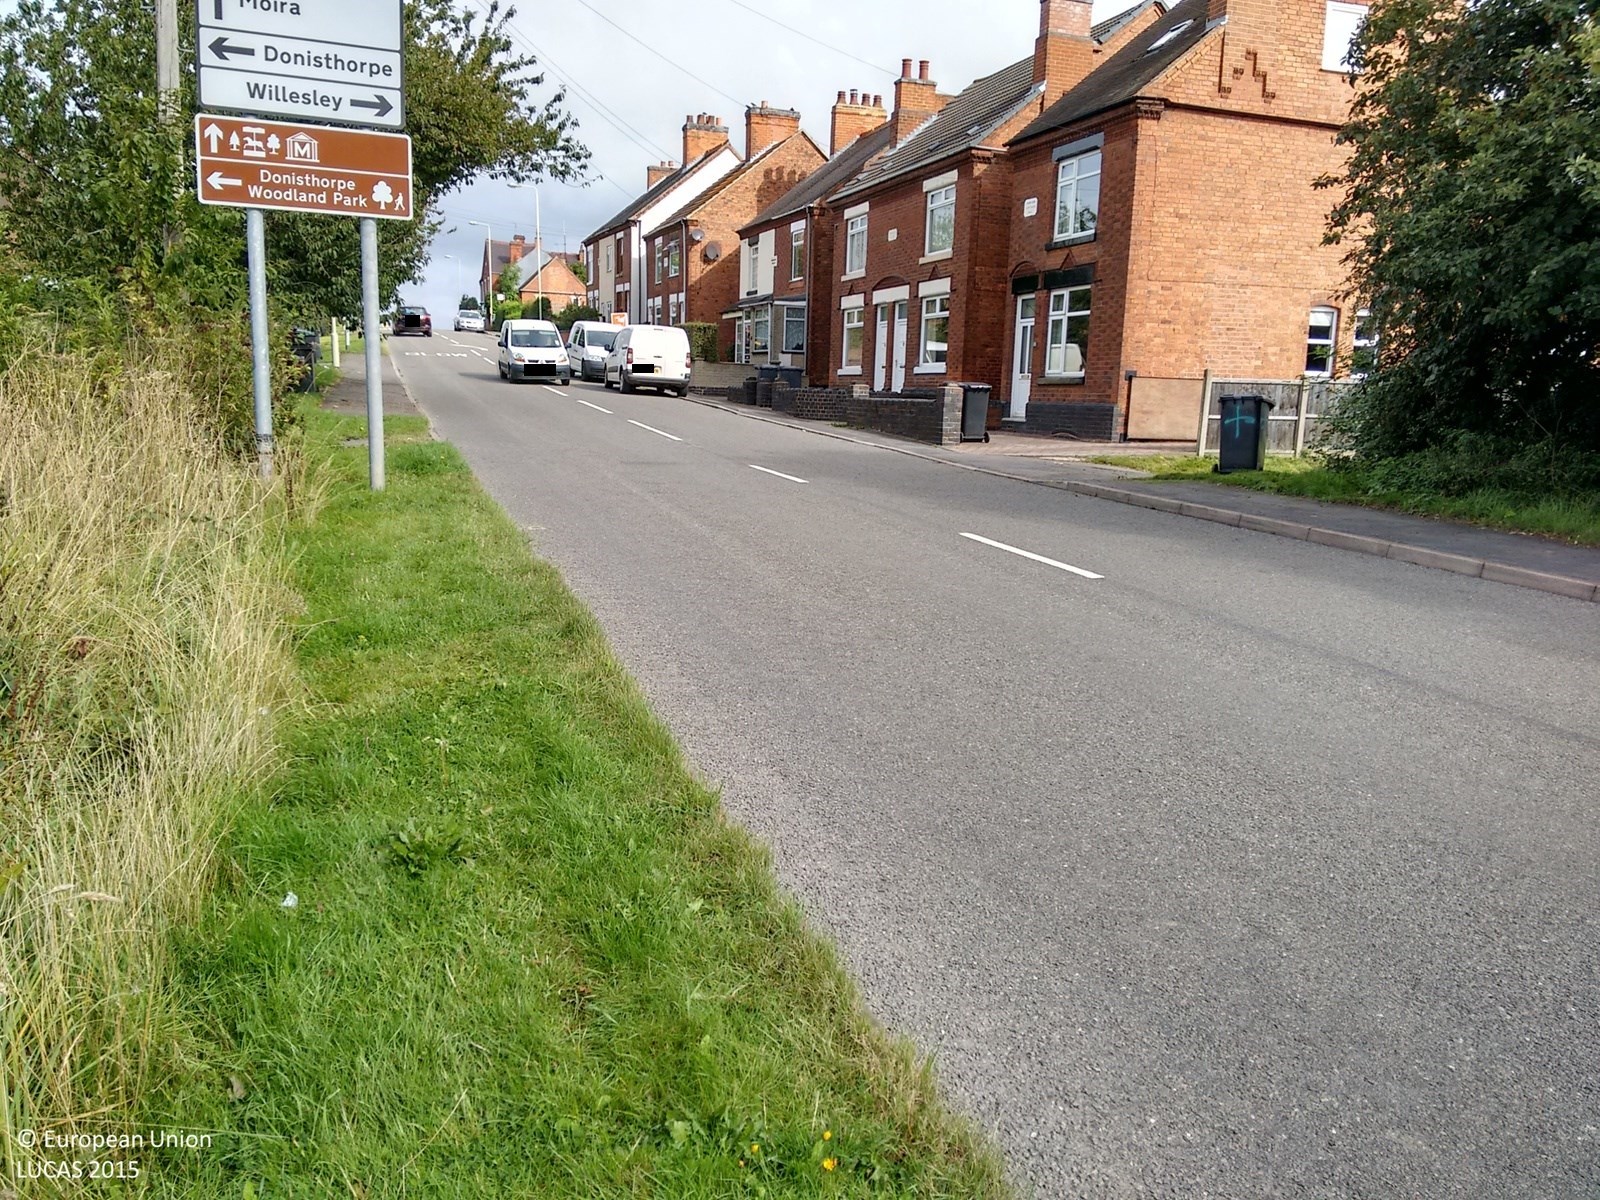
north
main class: Grassland
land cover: Grassland without tree/shrub cover
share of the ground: > 75 %
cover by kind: herbaceous plants 100 %
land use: Agriculture (excluding fallow land and kitchen gardens)
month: September
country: GB
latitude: 52.7223
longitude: -1.5255
